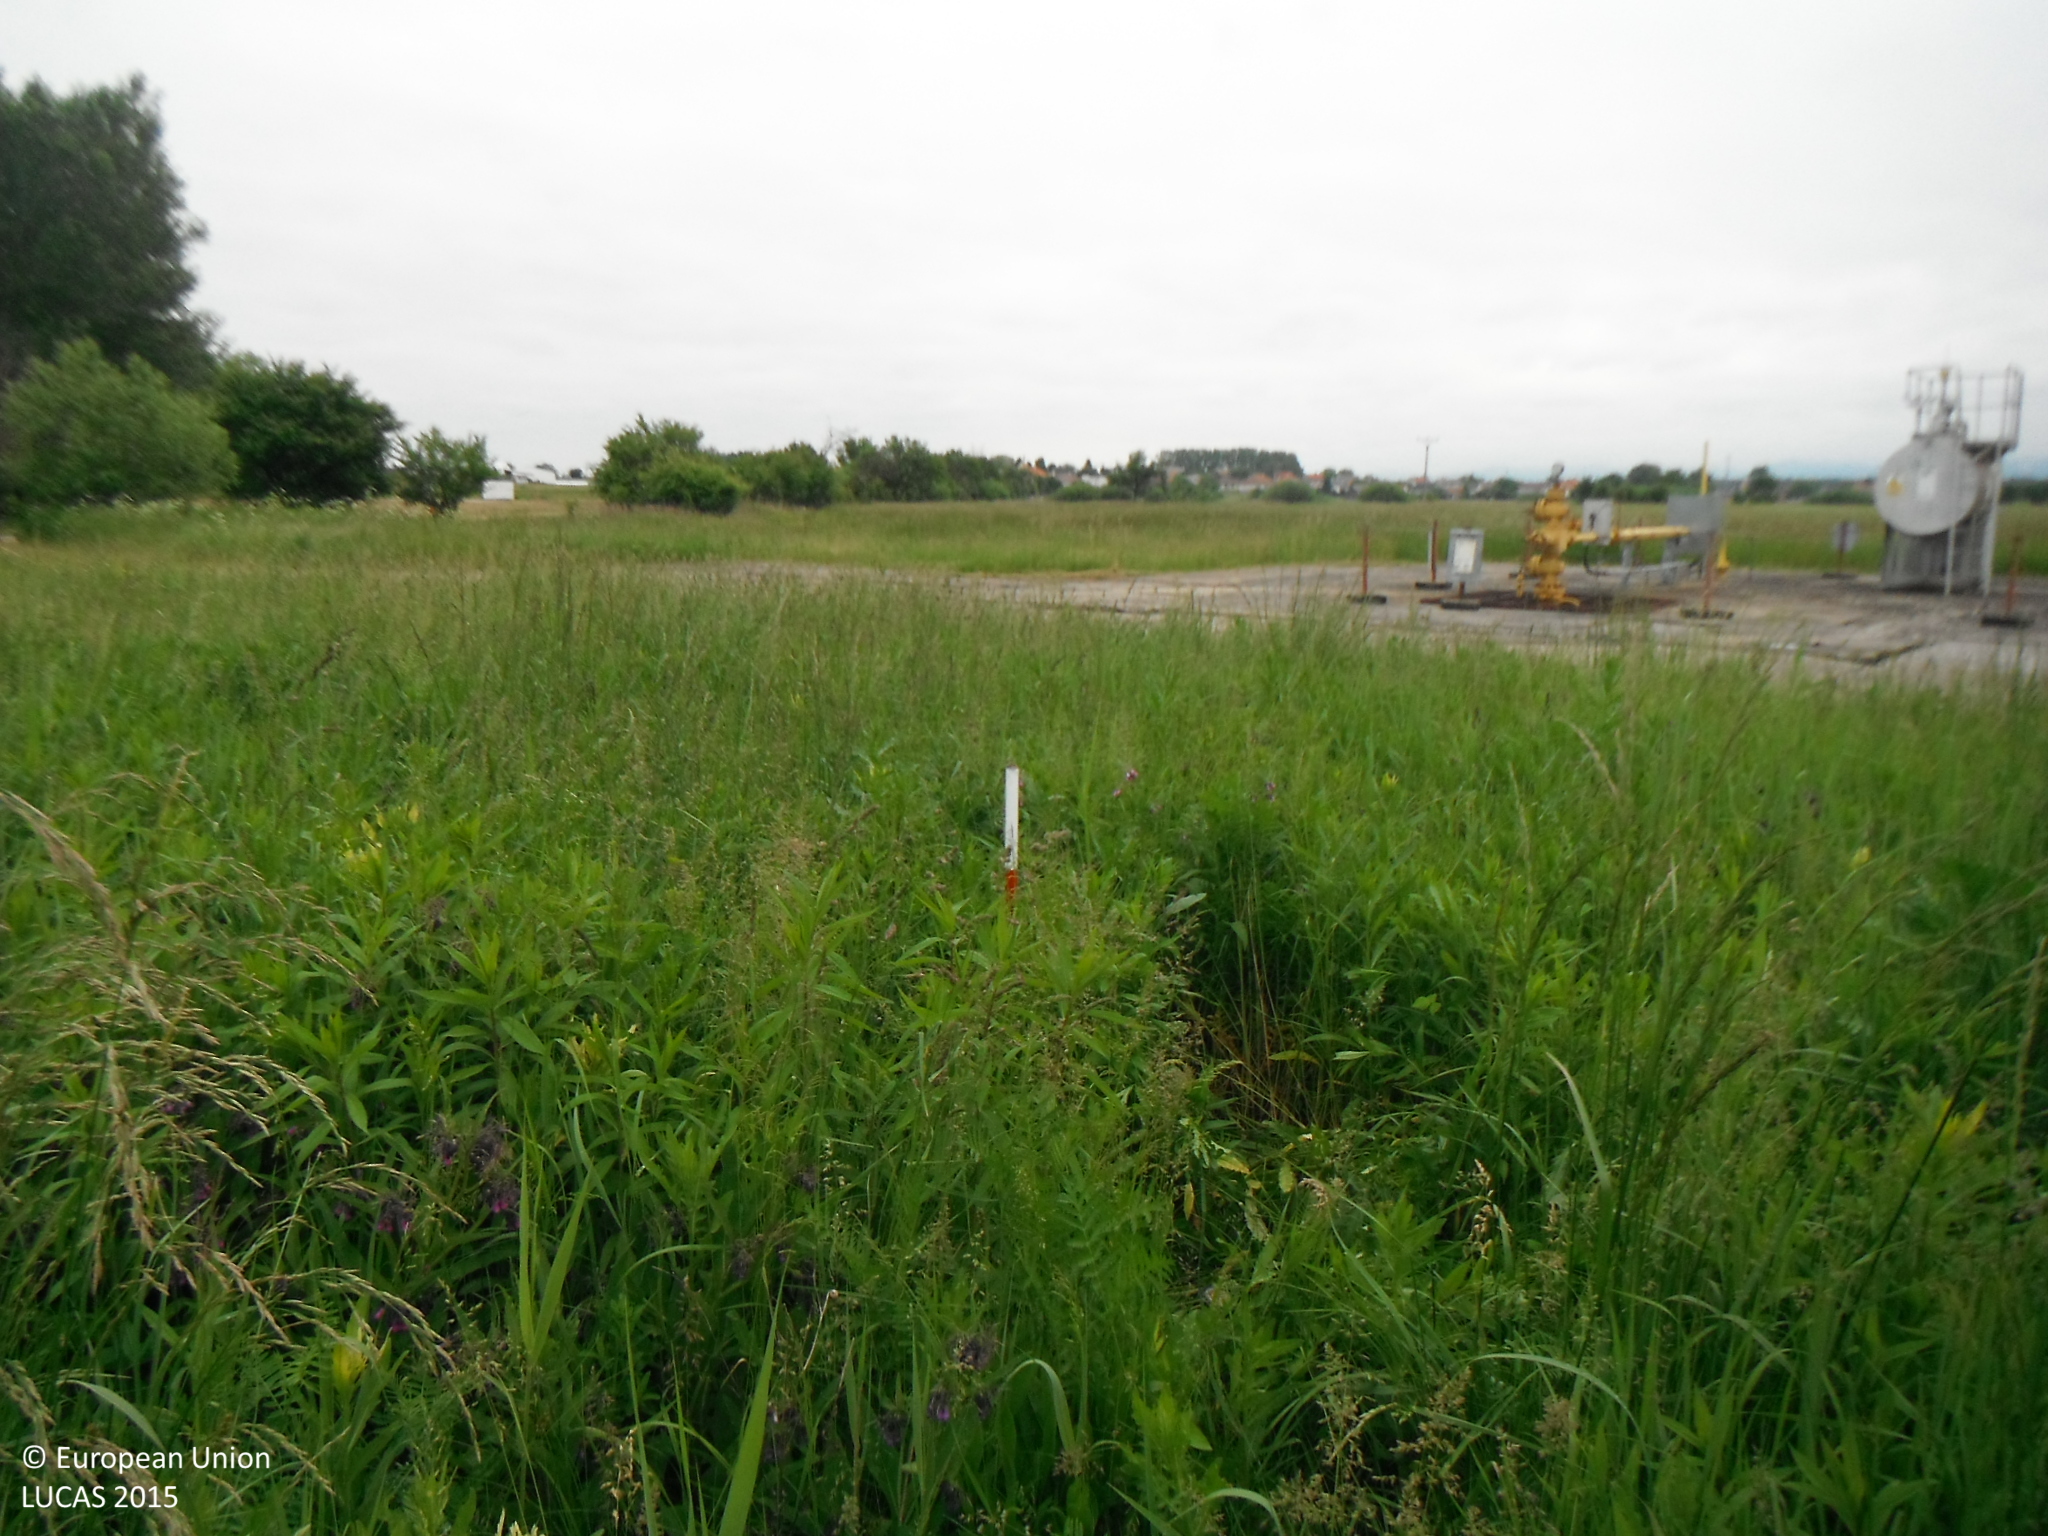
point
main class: Grassland
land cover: Grassland without tree/shrub cover
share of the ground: > 75 %
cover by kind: herbaceous plants 100 %
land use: Agriculture (excluding fallow land and kitchen gardens)
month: May
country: SK
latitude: 48.3647
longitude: 16.9591
